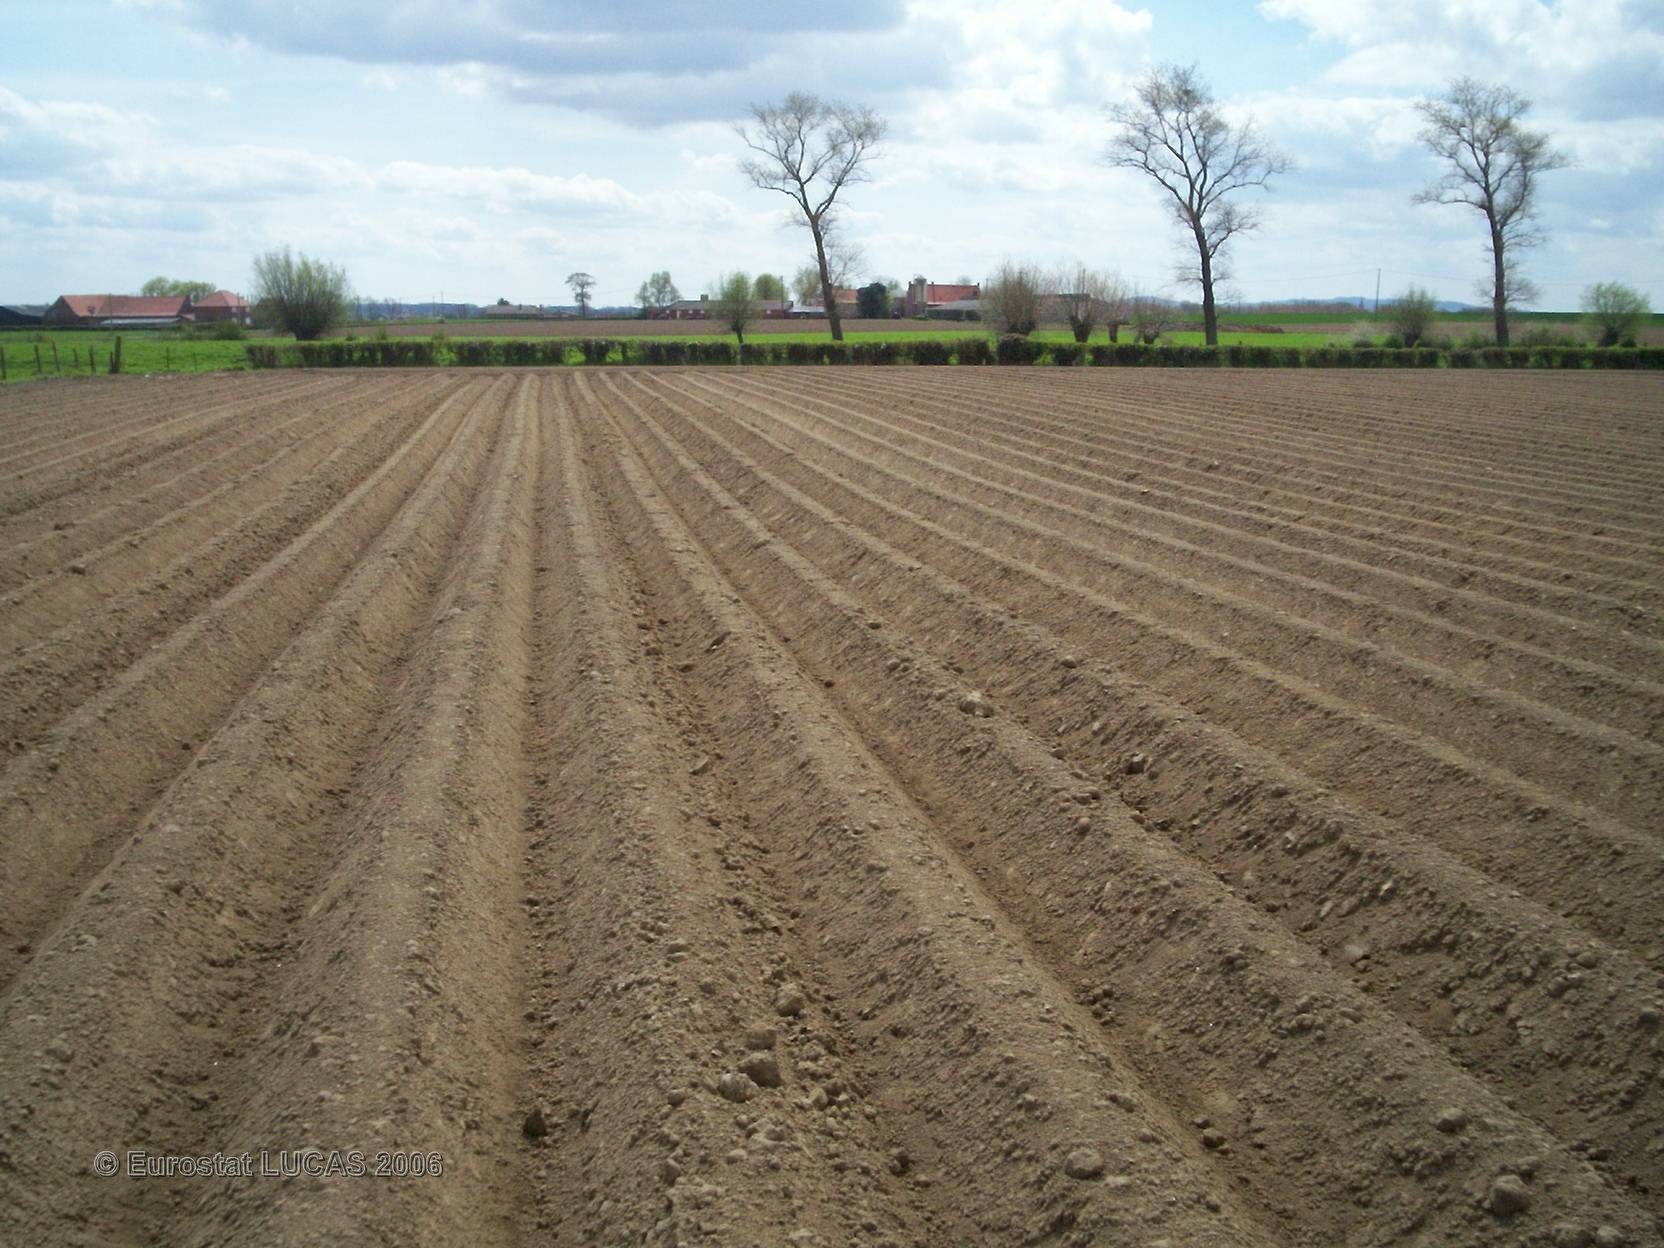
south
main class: Cropland
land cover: Potatoes
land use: Agriculture (excluding fallow land and kitchen gardens)
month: May
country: FR
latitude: 50.9154
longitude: 2.5485
